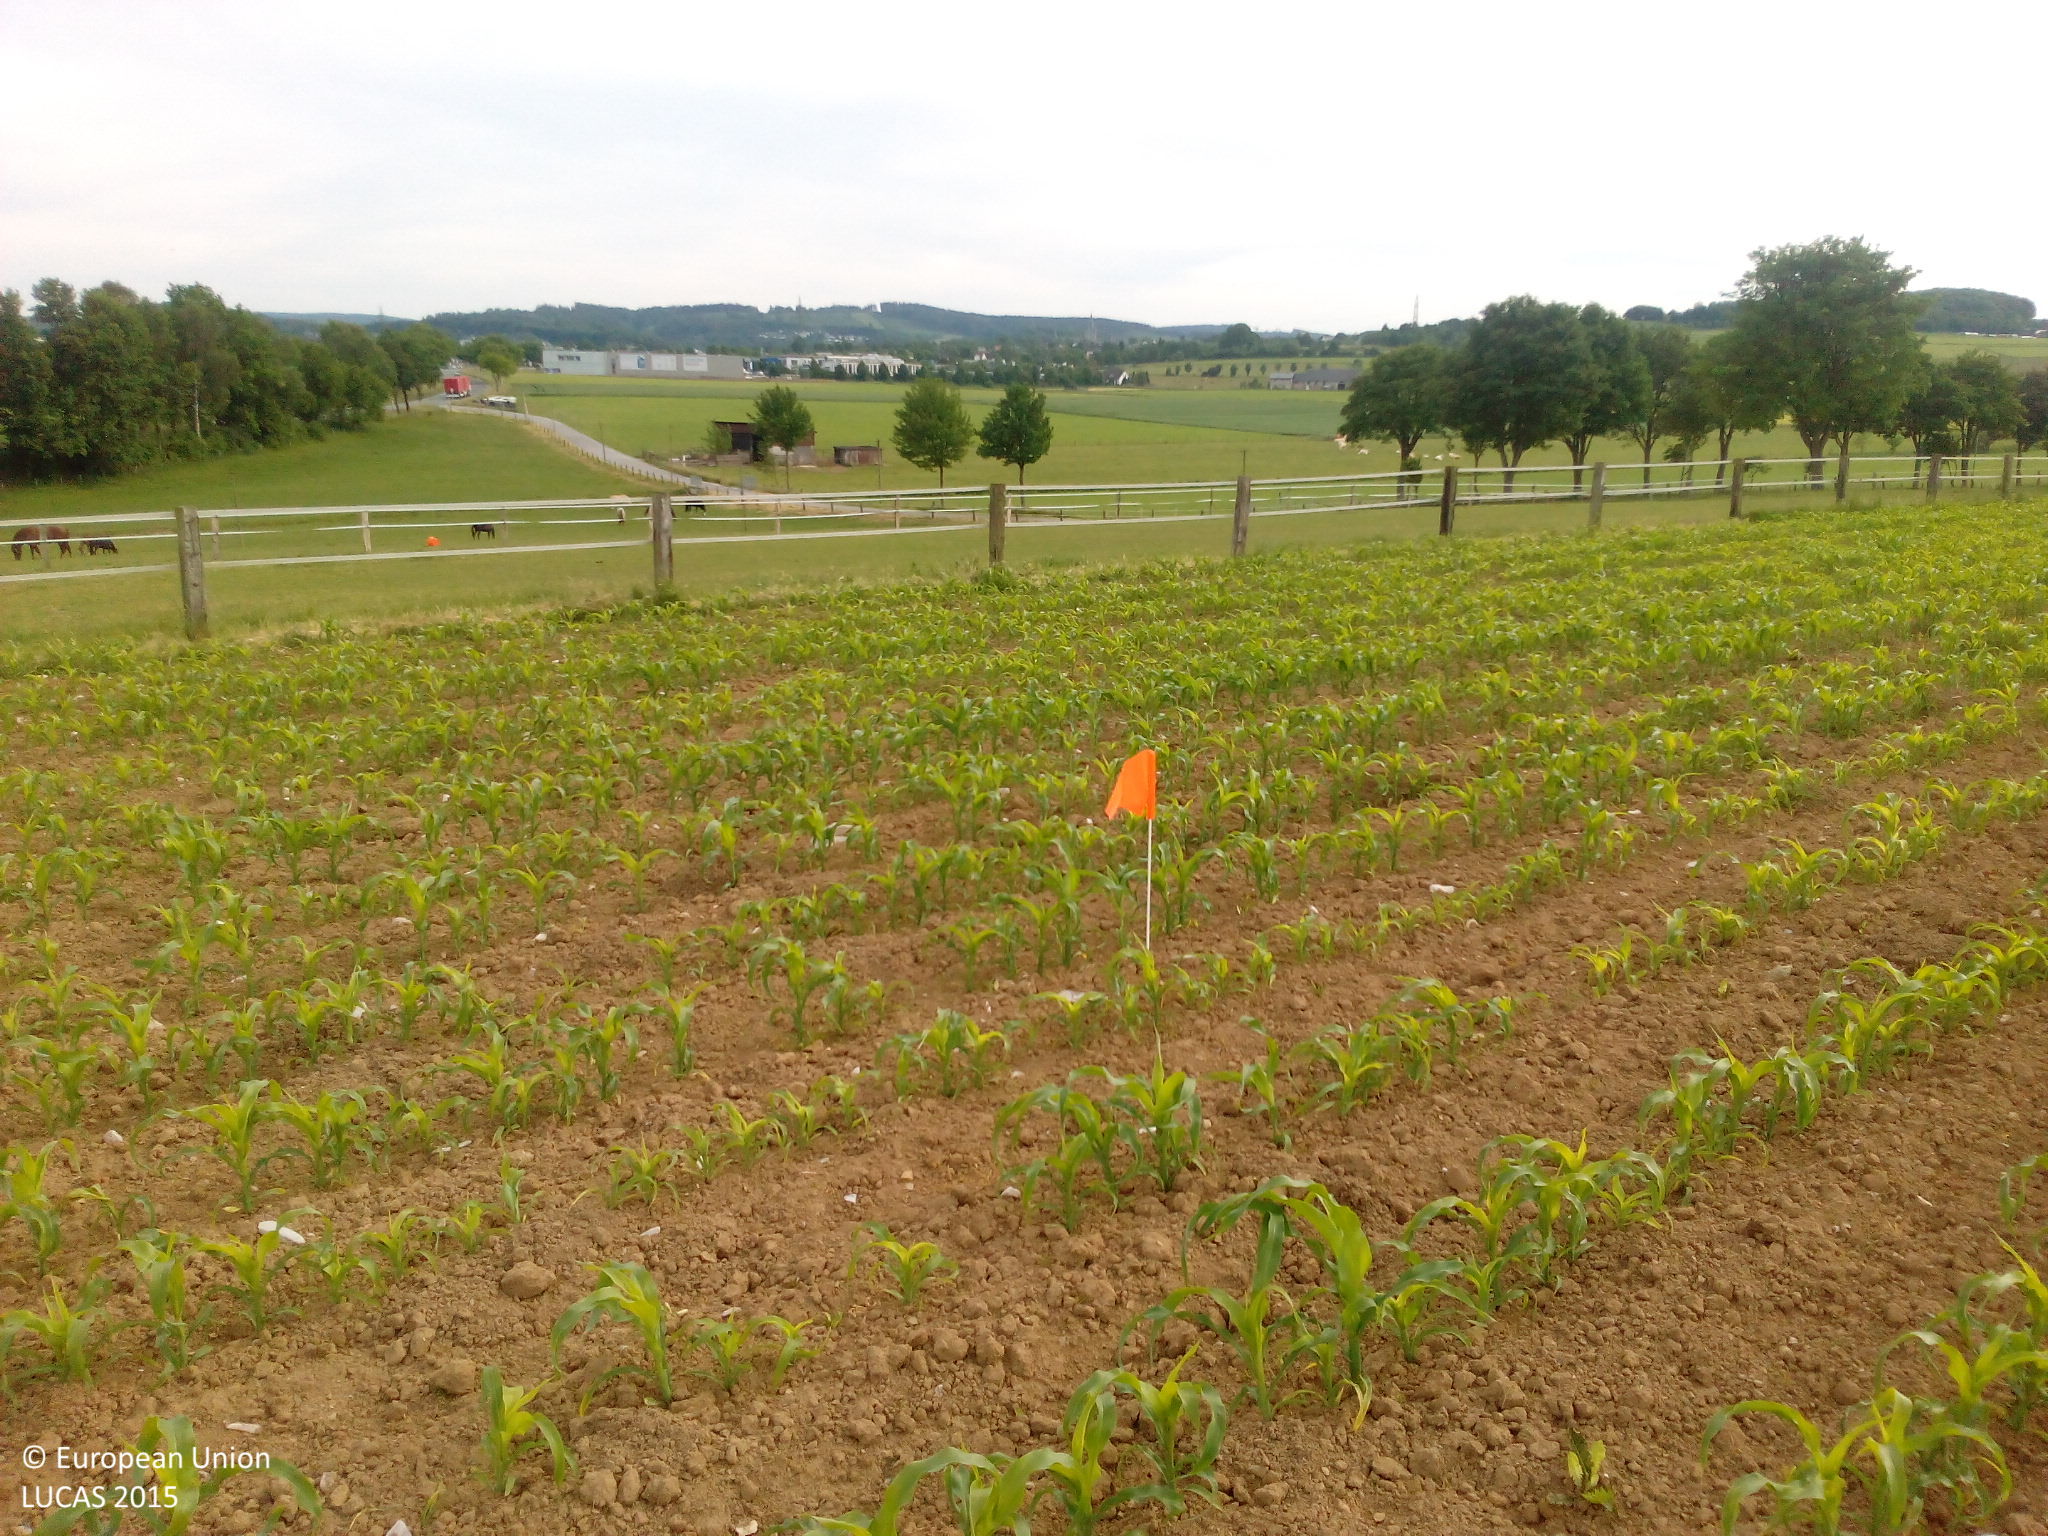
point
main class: Cropland
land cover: Maize
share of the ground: 25 - 50 %
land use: Agriculture (excluding fallow land and kitchen gardens)
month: June
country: DE
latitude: 51.4161
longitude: 8.5768
